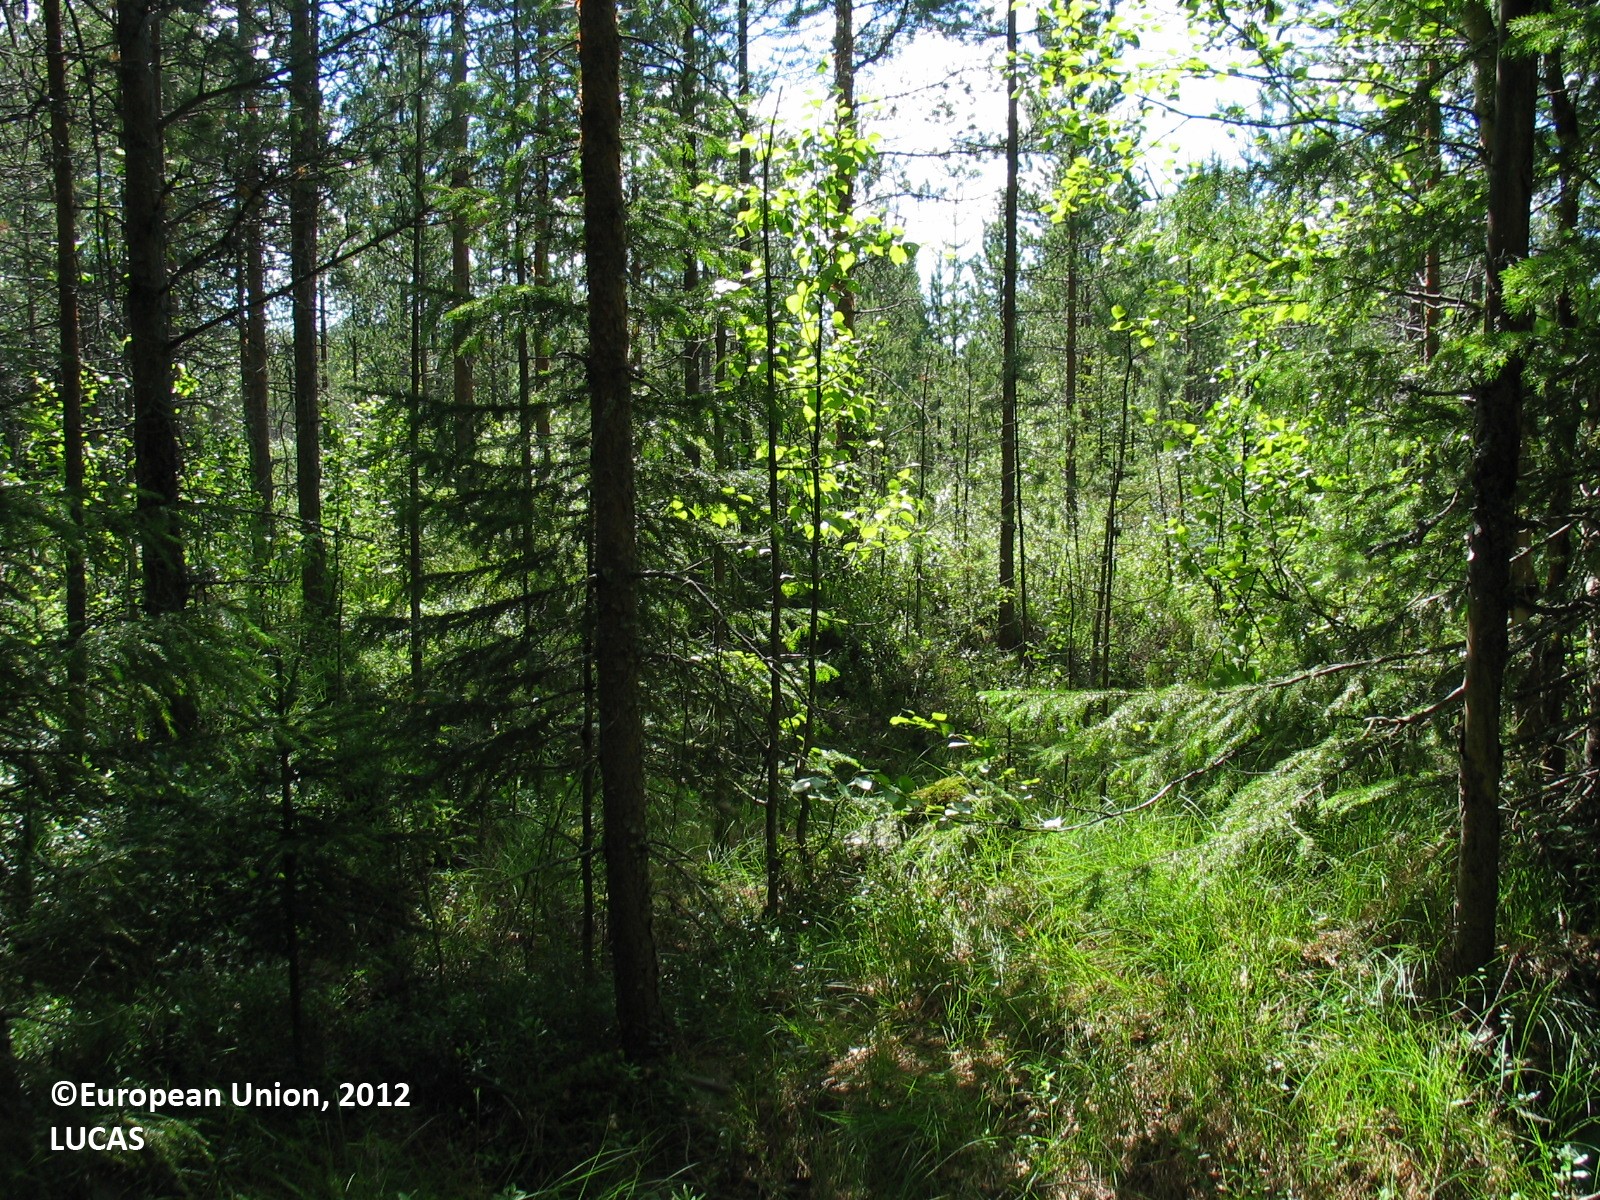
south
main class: Woodland
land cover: Pine dominated coniferous woodland
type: mire and swamp forests
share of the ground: 50 - 75 %
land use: Forestry
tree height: > 5 m
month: July
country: FI
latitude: 65.8180
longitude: 25.0500
